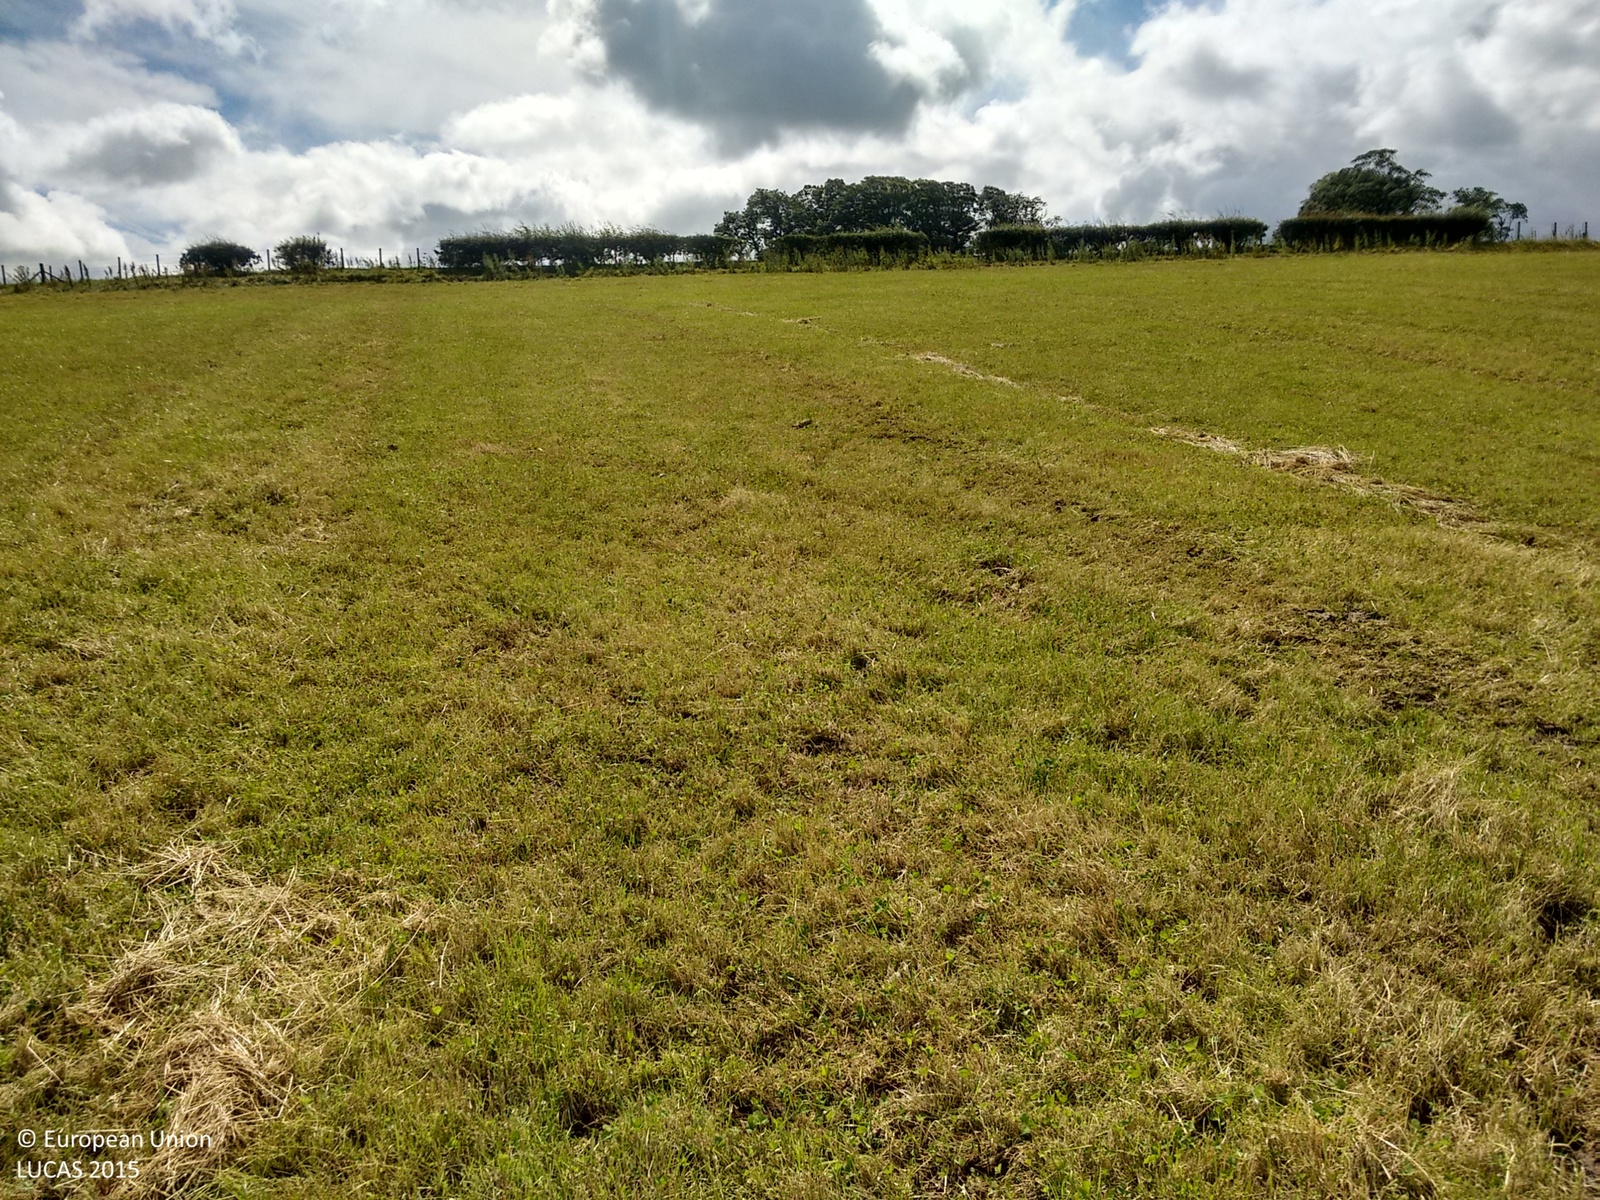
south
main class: Grassland
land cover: Grassland without tree/shrub cover
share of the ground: > 75 %
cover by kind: herbaceous plants 100 %
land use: Agriculture (excluding fallow land and kitchen gardens)
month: August
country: GB
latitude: 55.5898
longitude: -4.3934
